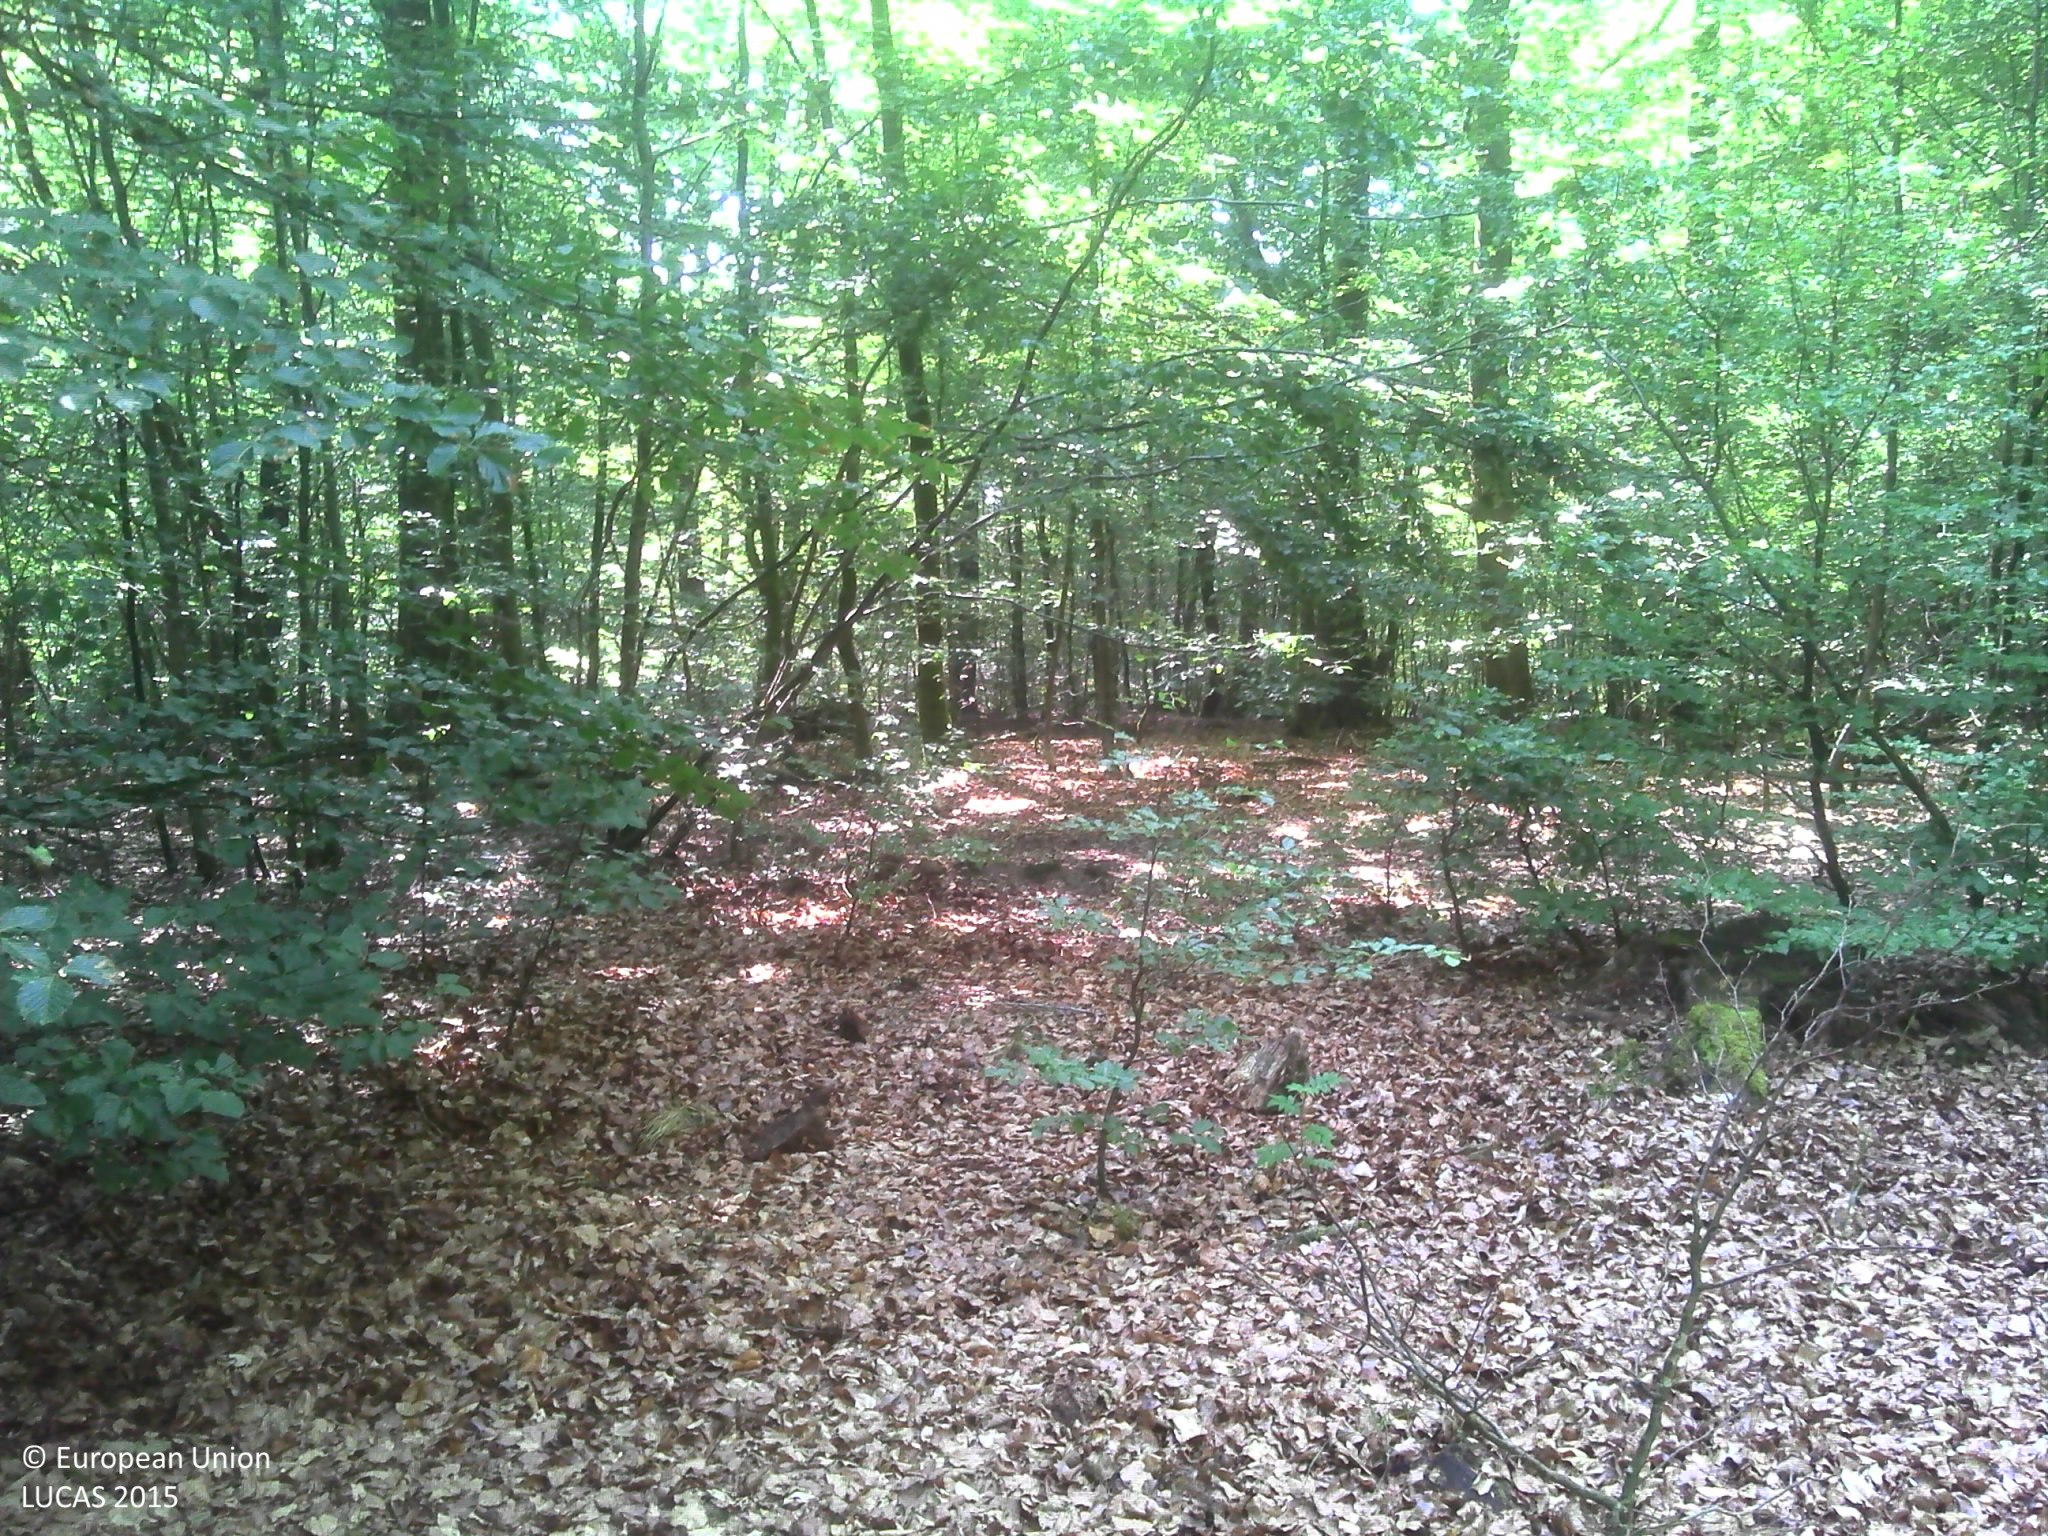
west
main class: Woodland
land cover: Broadleaved woodland
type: beech forest
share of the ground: > 75 %
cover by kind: broadleaved forest trees 80 %, shrubs 10 %, herbaceous plants 5 %, unconsolidated bare surface 5 %
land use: Forestry
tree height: > 5 m
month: July
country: BE
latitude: 49.8141
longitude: 5.6766
